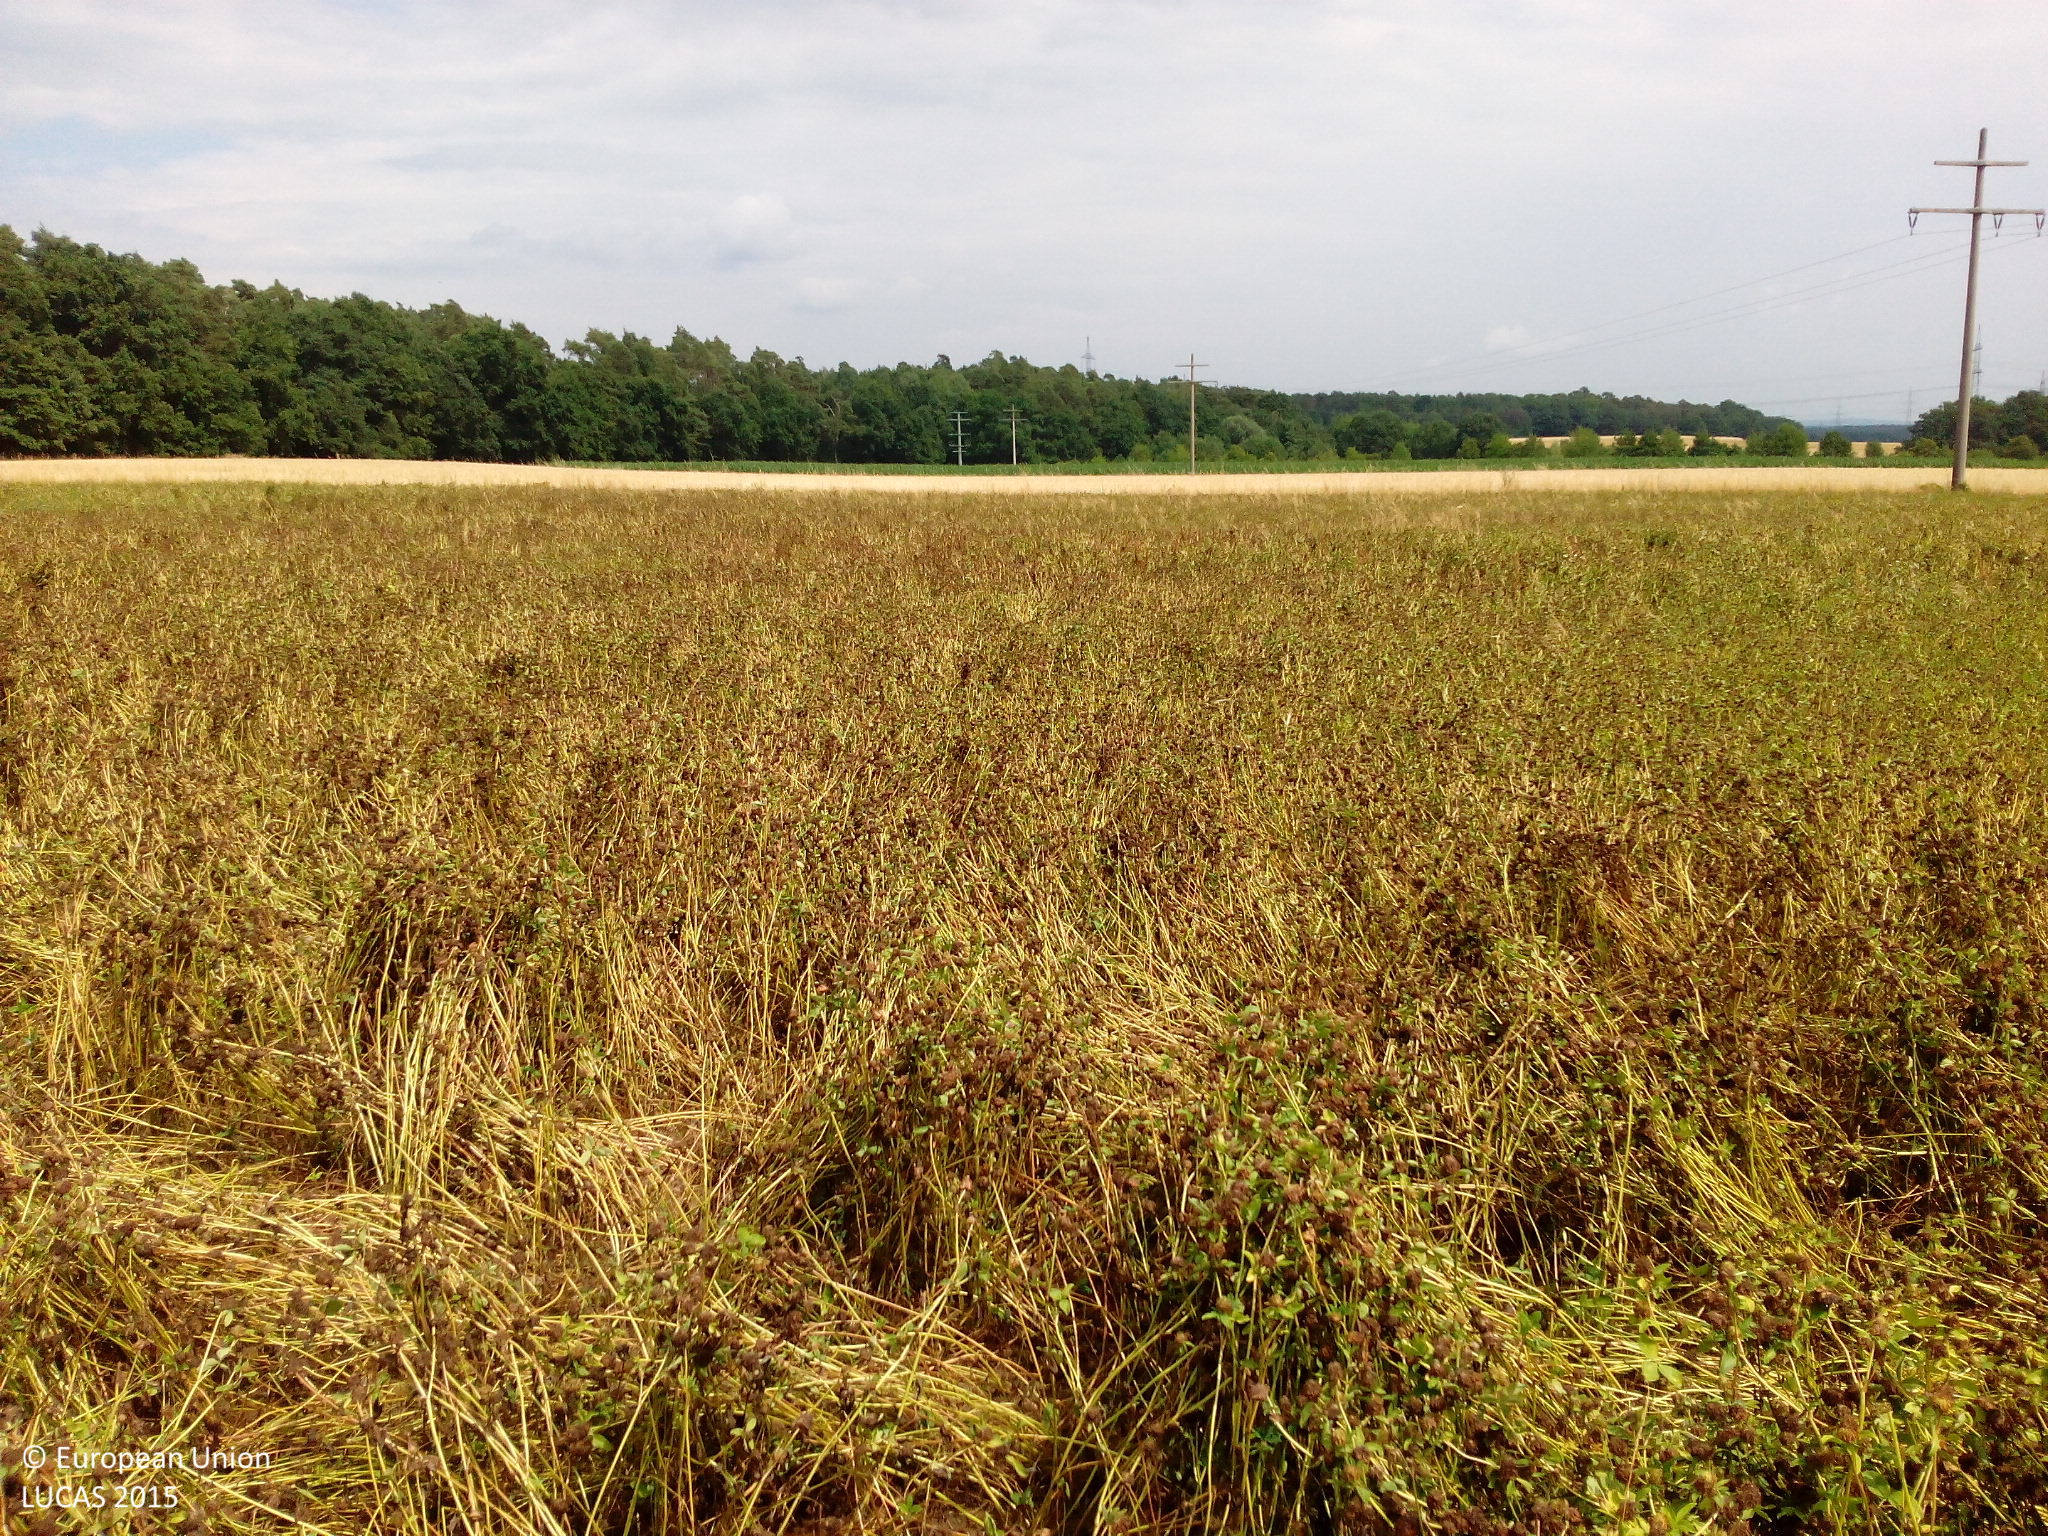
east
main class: Cropland
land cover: Clovers
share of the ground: > 75 %
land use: Agriculture (excluding fallow land and kitchen gardens)
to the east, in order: Clovers; Grassland without tree/shrub cover; Rape and turnip rape; Maize; Electric lines; Maize
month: July
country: DE
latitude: 49.5690
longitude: 10.9261
